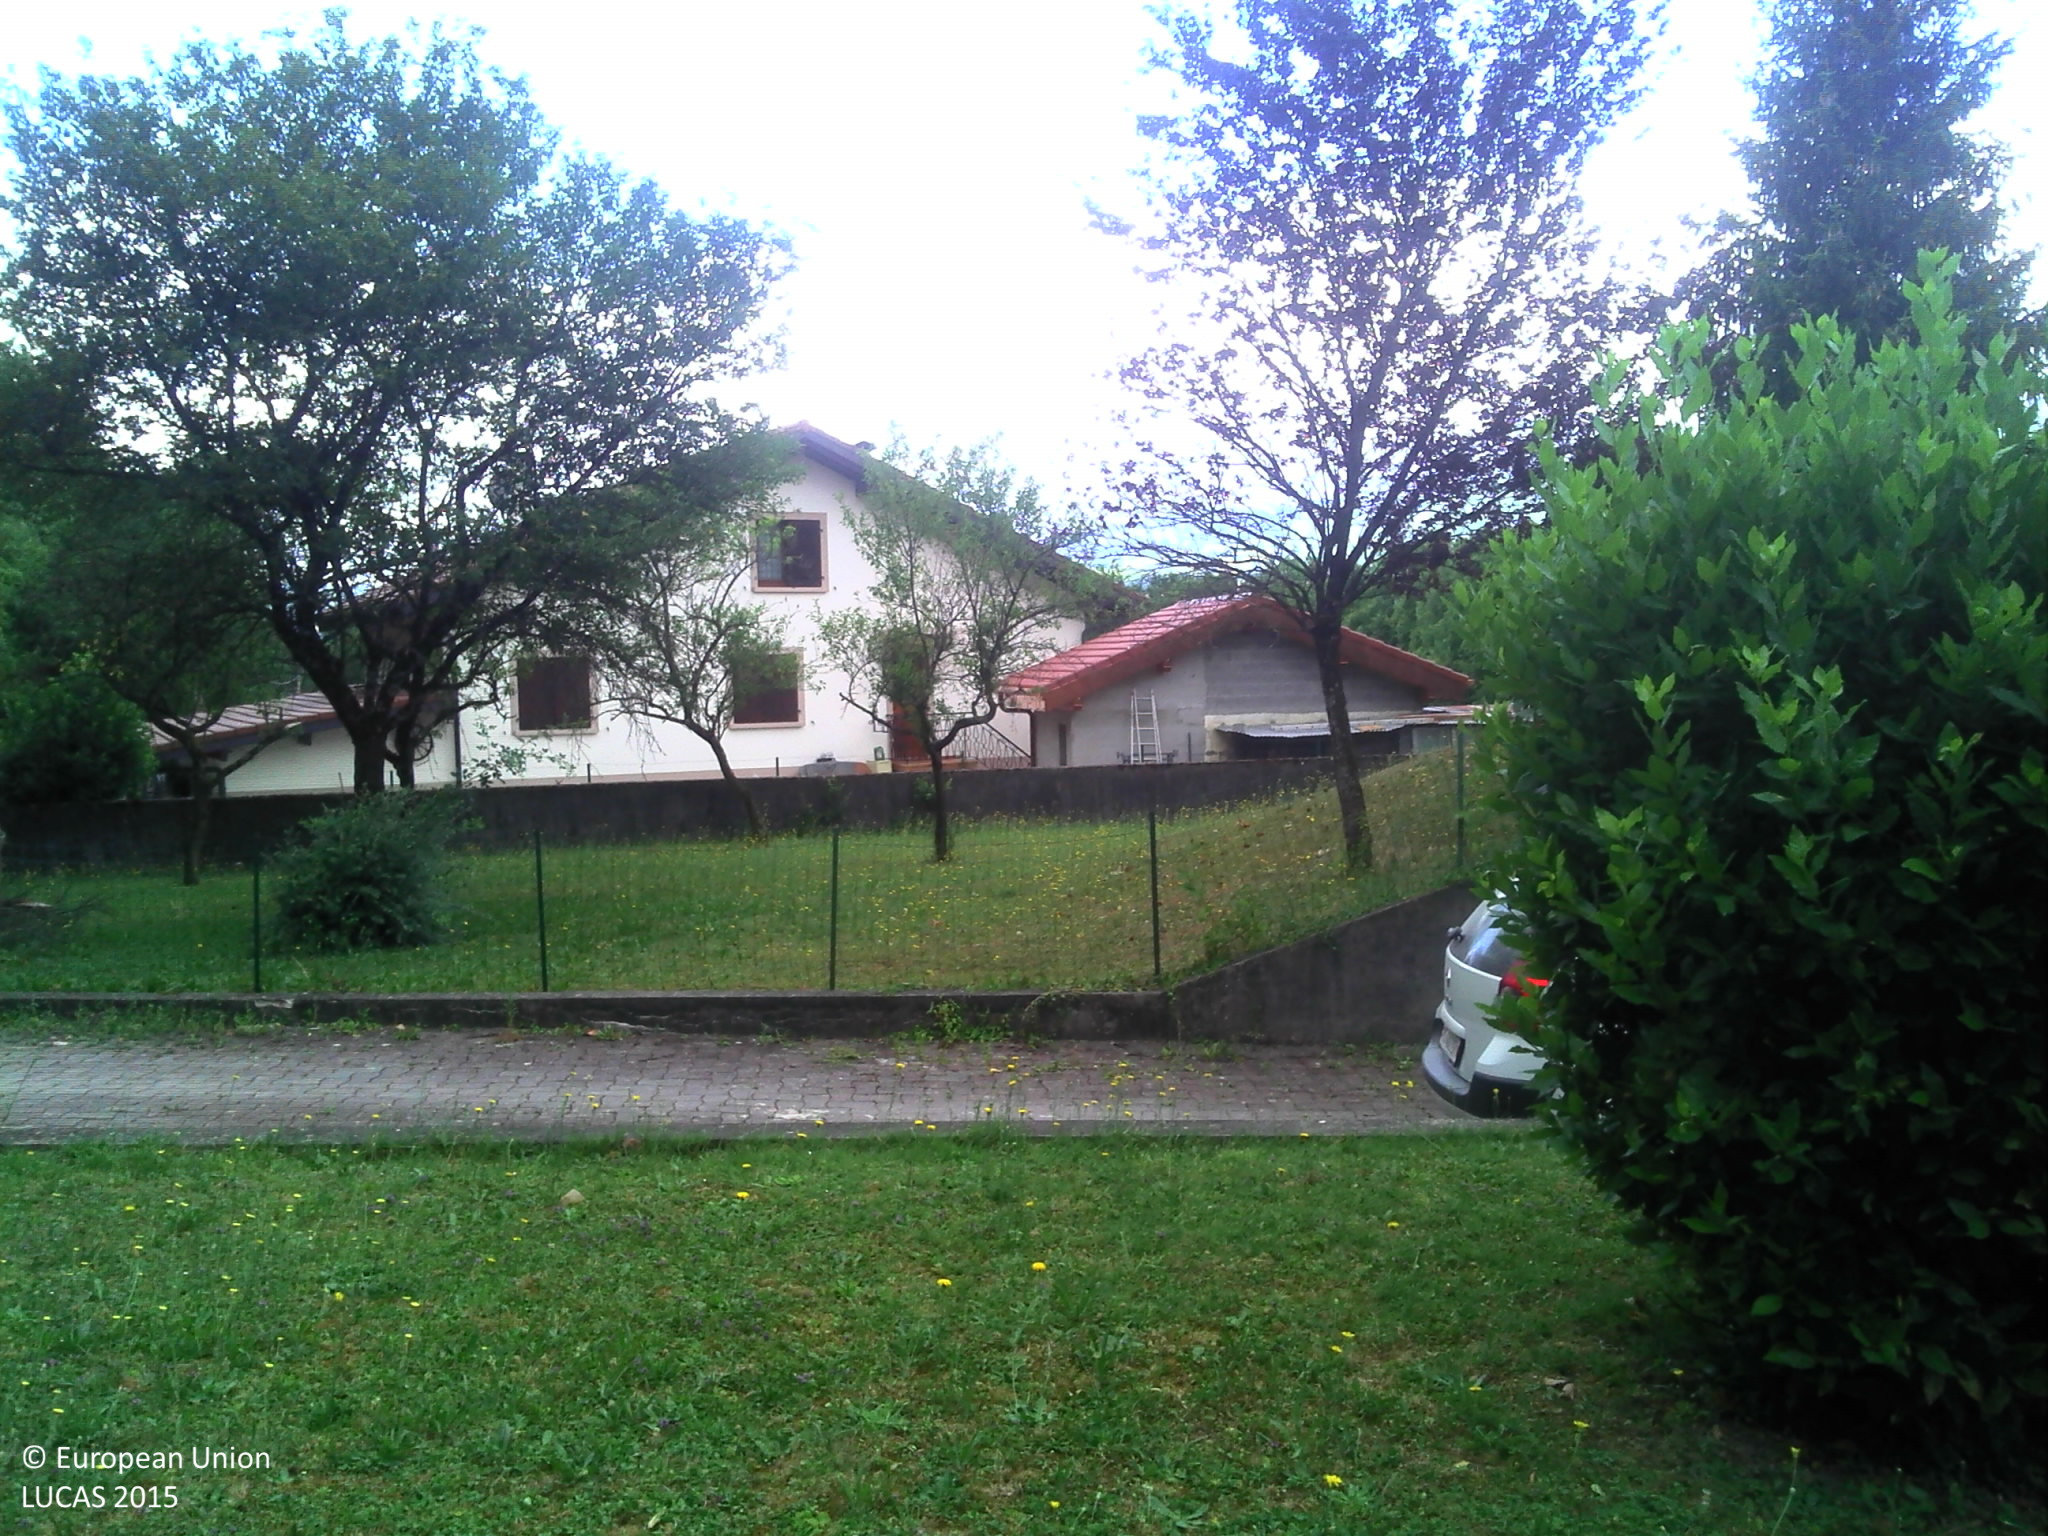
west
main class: Grassland
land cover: Grassland with sparse tree/shrub cover
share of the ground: > 75 %
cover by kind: herbaceous plants 95 %, broadleaved forest trees 5 %
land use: Residential
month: July
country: FR
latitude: 46.1606
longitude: 6.2869
